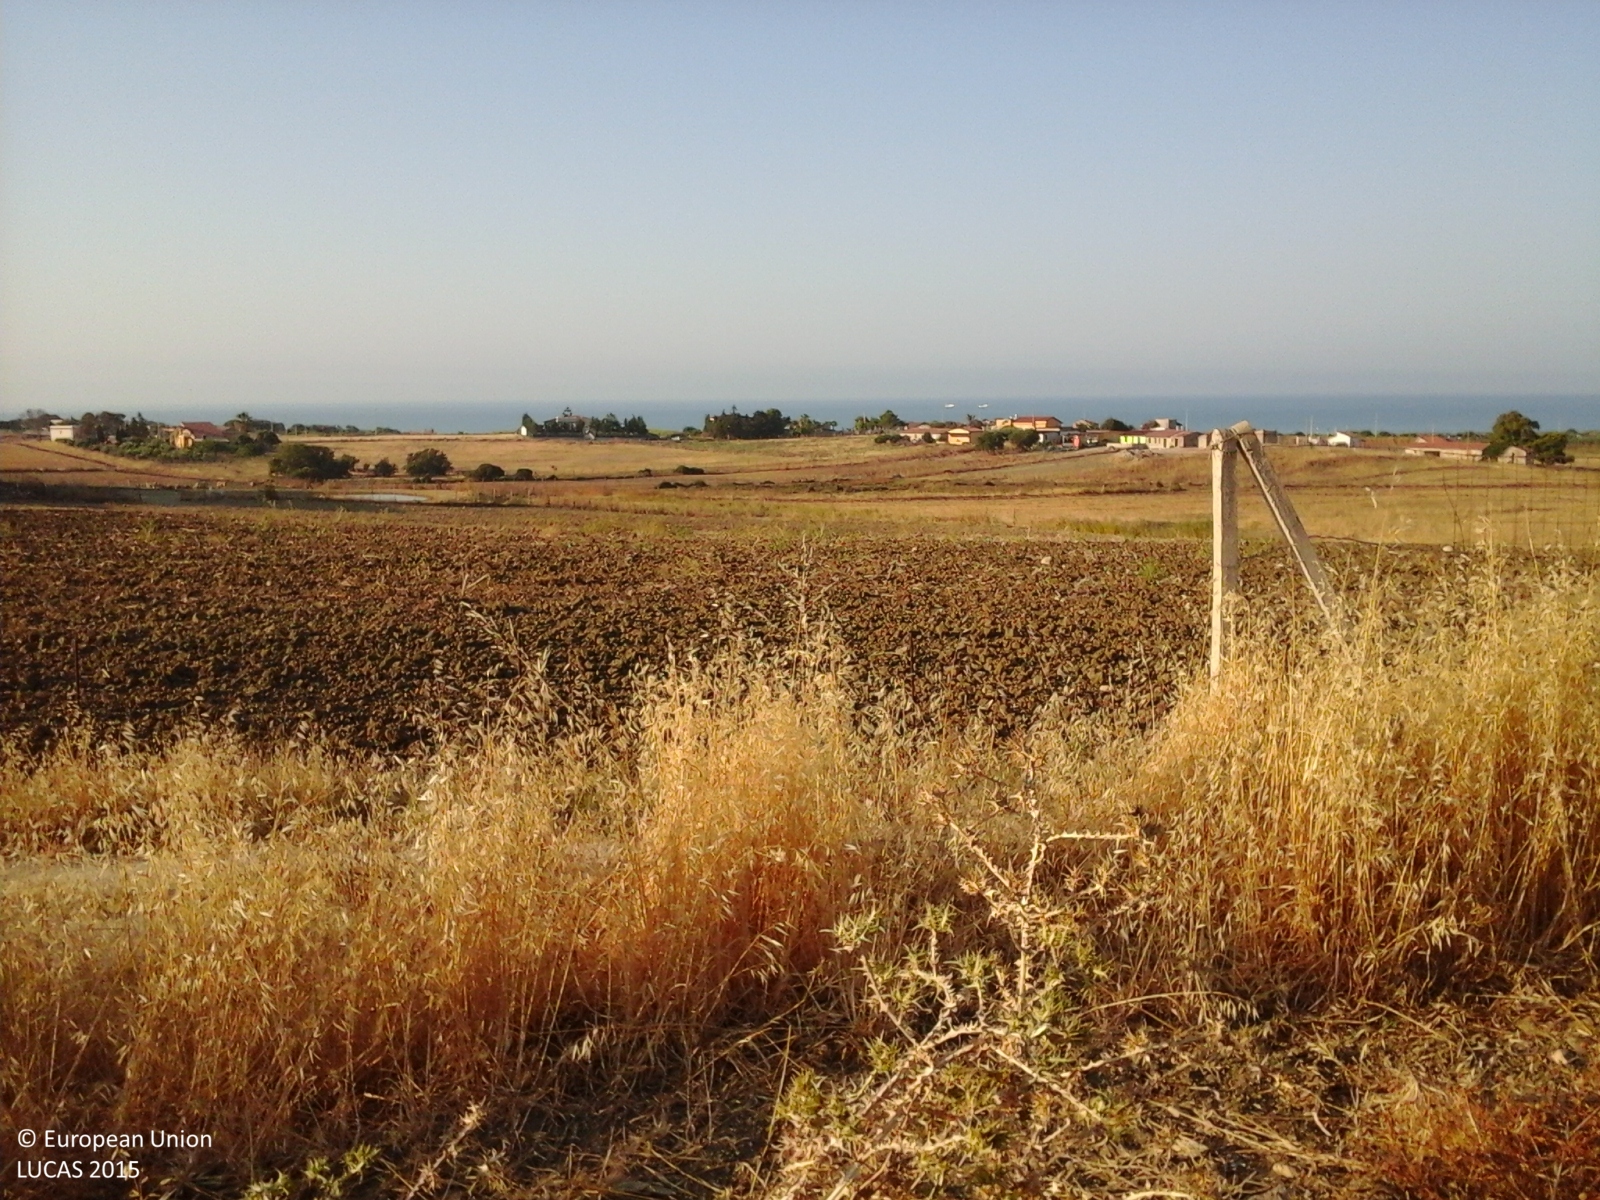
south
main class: Cropland
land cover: Other leguminous and mixtures for fodder
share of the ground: > 75 %
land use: Agriculture (excluding fallow land and kitchen gardens)
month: July
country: IT
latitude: 37.1138
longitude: 14.0978
